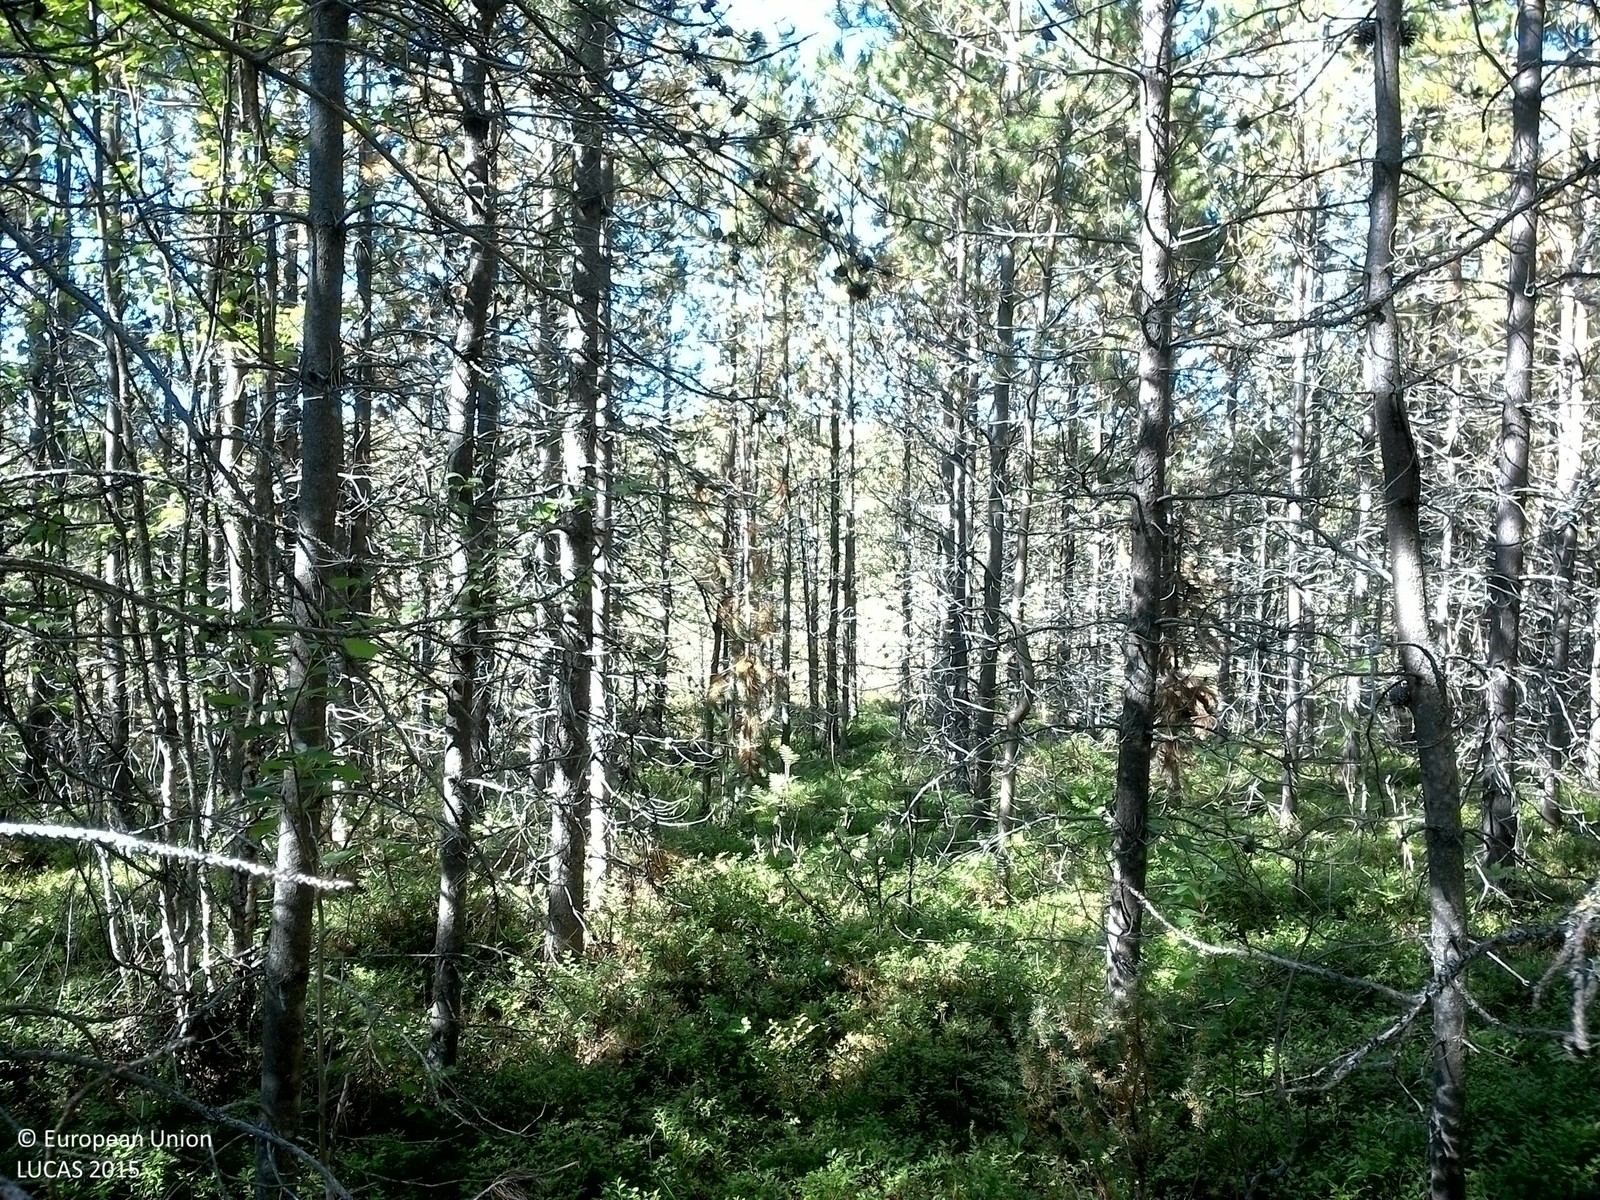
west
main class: Woodland
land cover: Pine dominated coniferous woodland
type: exotic forest
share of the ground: > 75 %
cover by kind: coniferous forest trees 80 %, shrubs 20 %
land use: Forestry
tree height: > 5 m
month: August
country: SE
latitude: 63.9267
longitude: 17.5776
